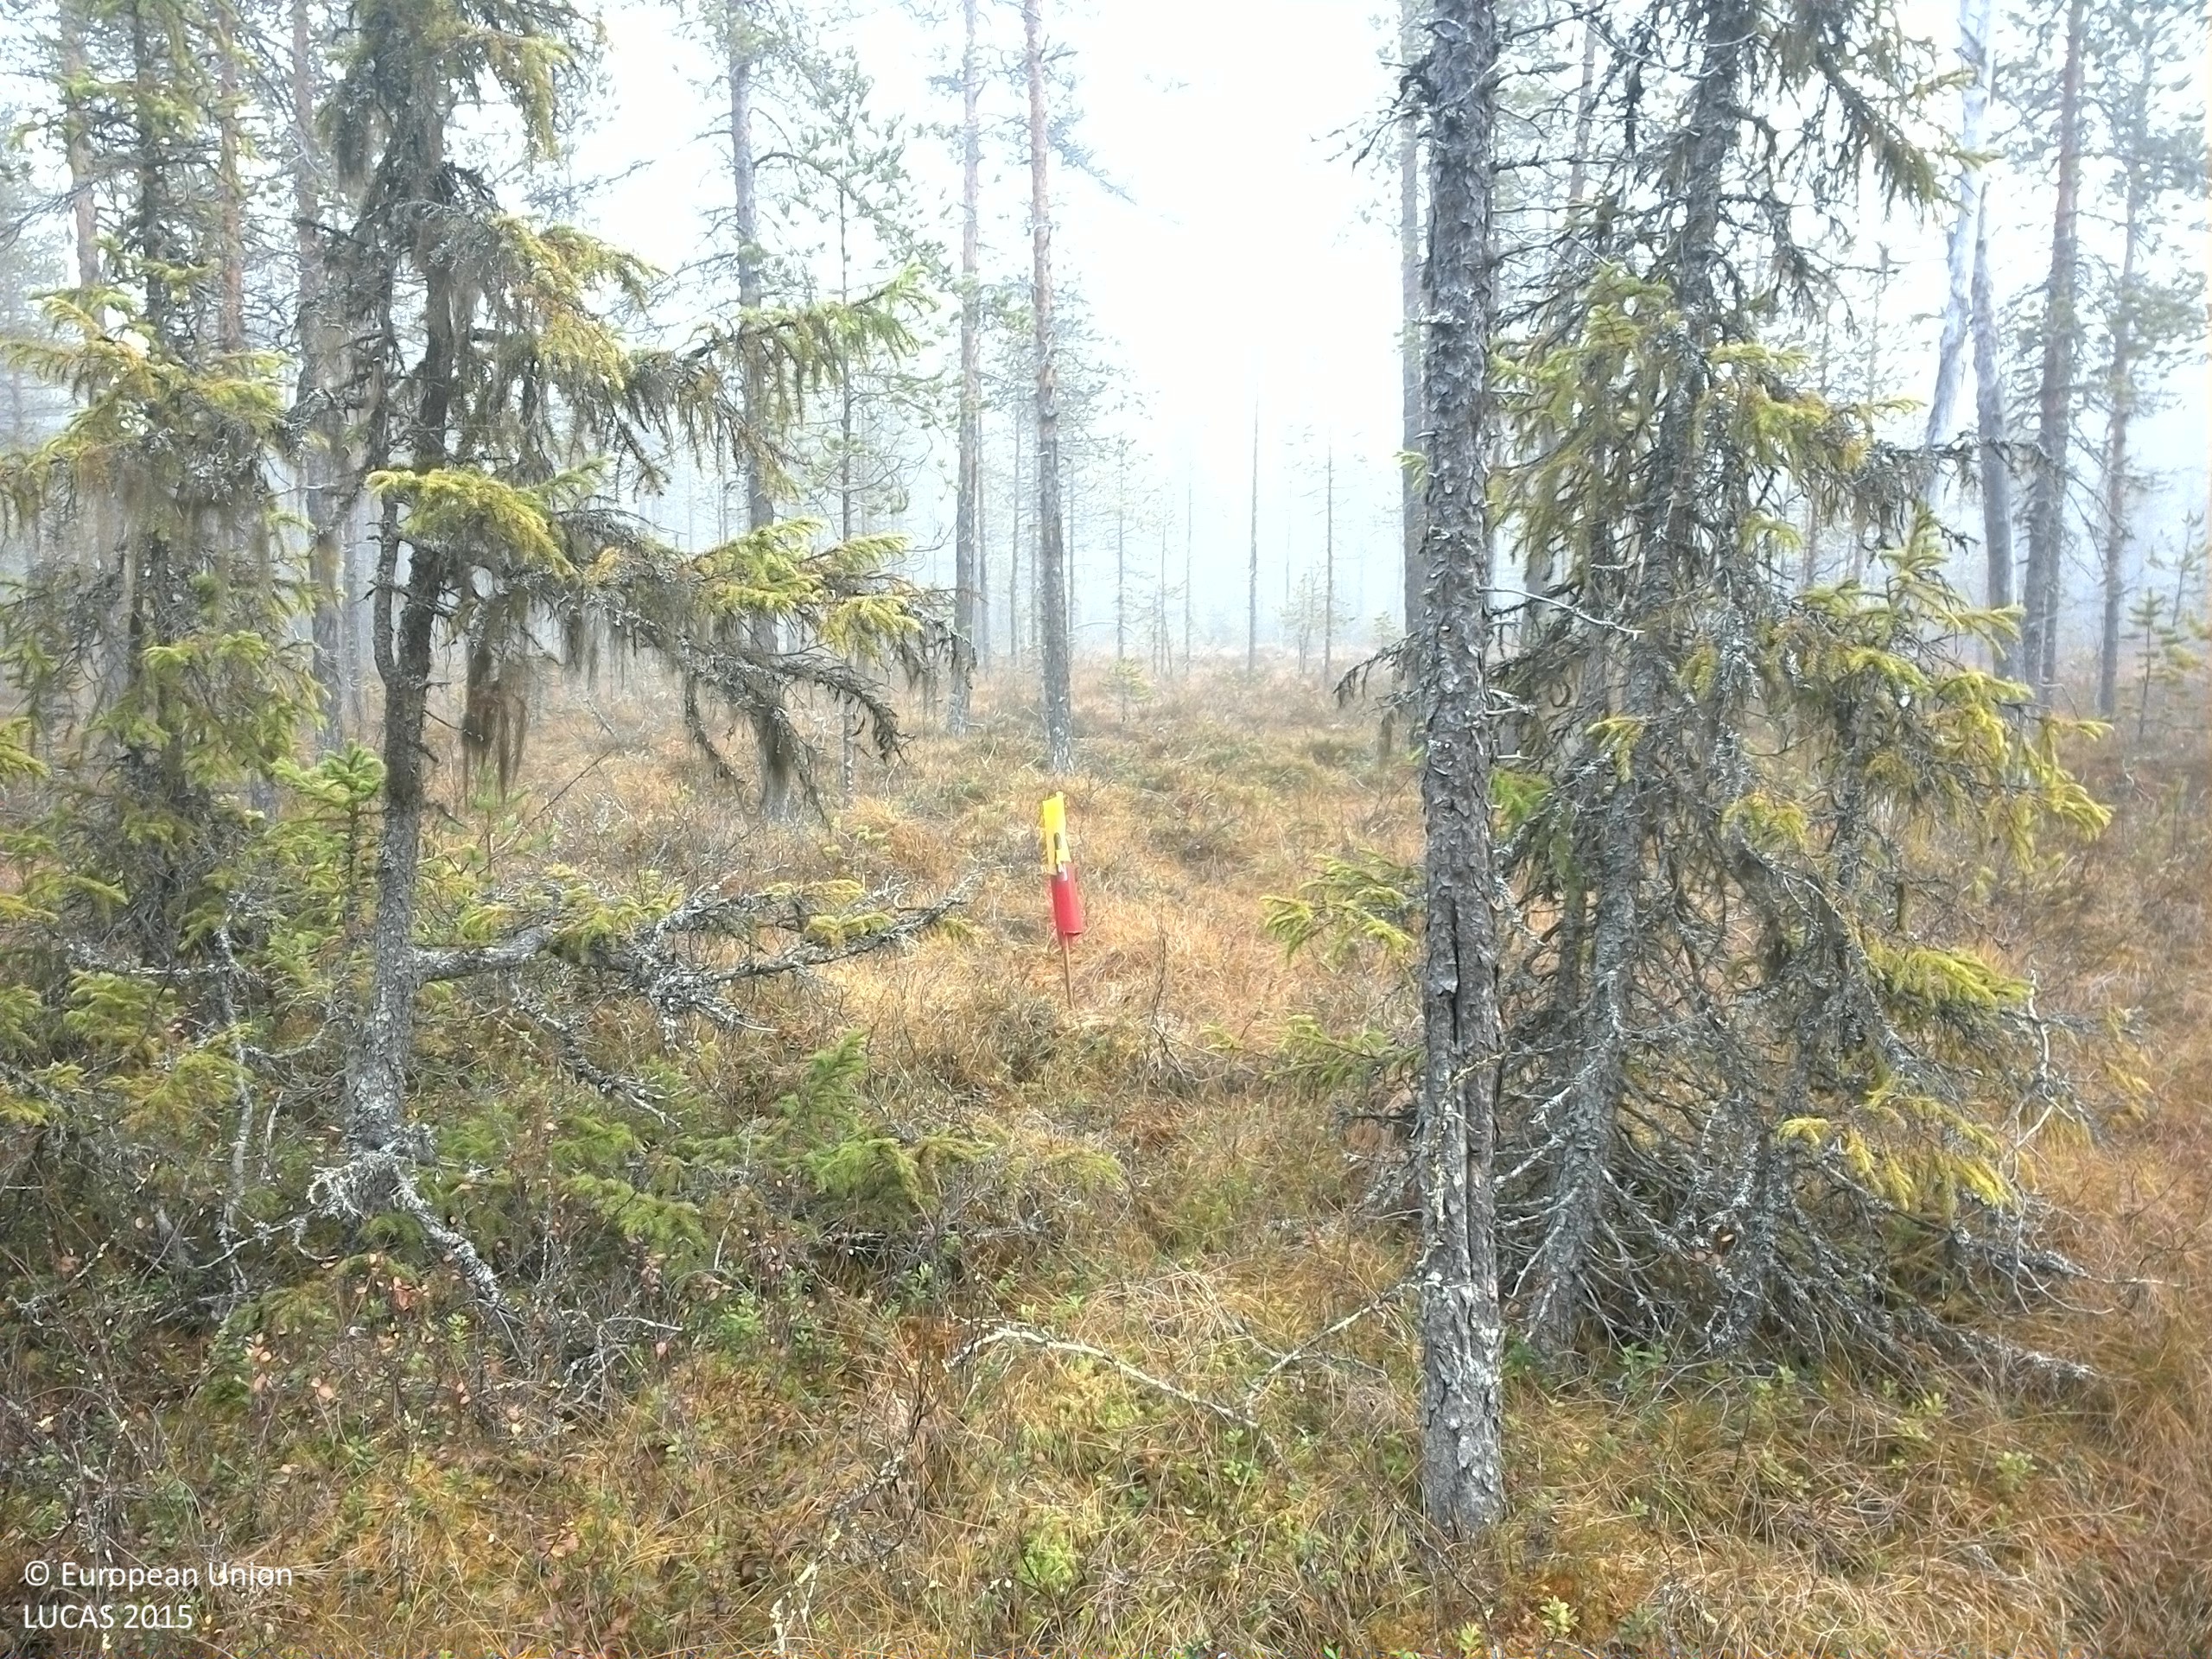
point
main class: Woodland
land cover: Pine dominated coniferous woodland
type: boreal forest
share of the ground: 25 - 50 %
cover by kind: coniferous forest trees 30 %, shrubs 25 %, lichens and mosses 25 %, herbaceous plants 20 %
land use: Forestry
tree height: > 5 m
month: October
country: SE
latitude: 64.0523
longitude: 16.3822
